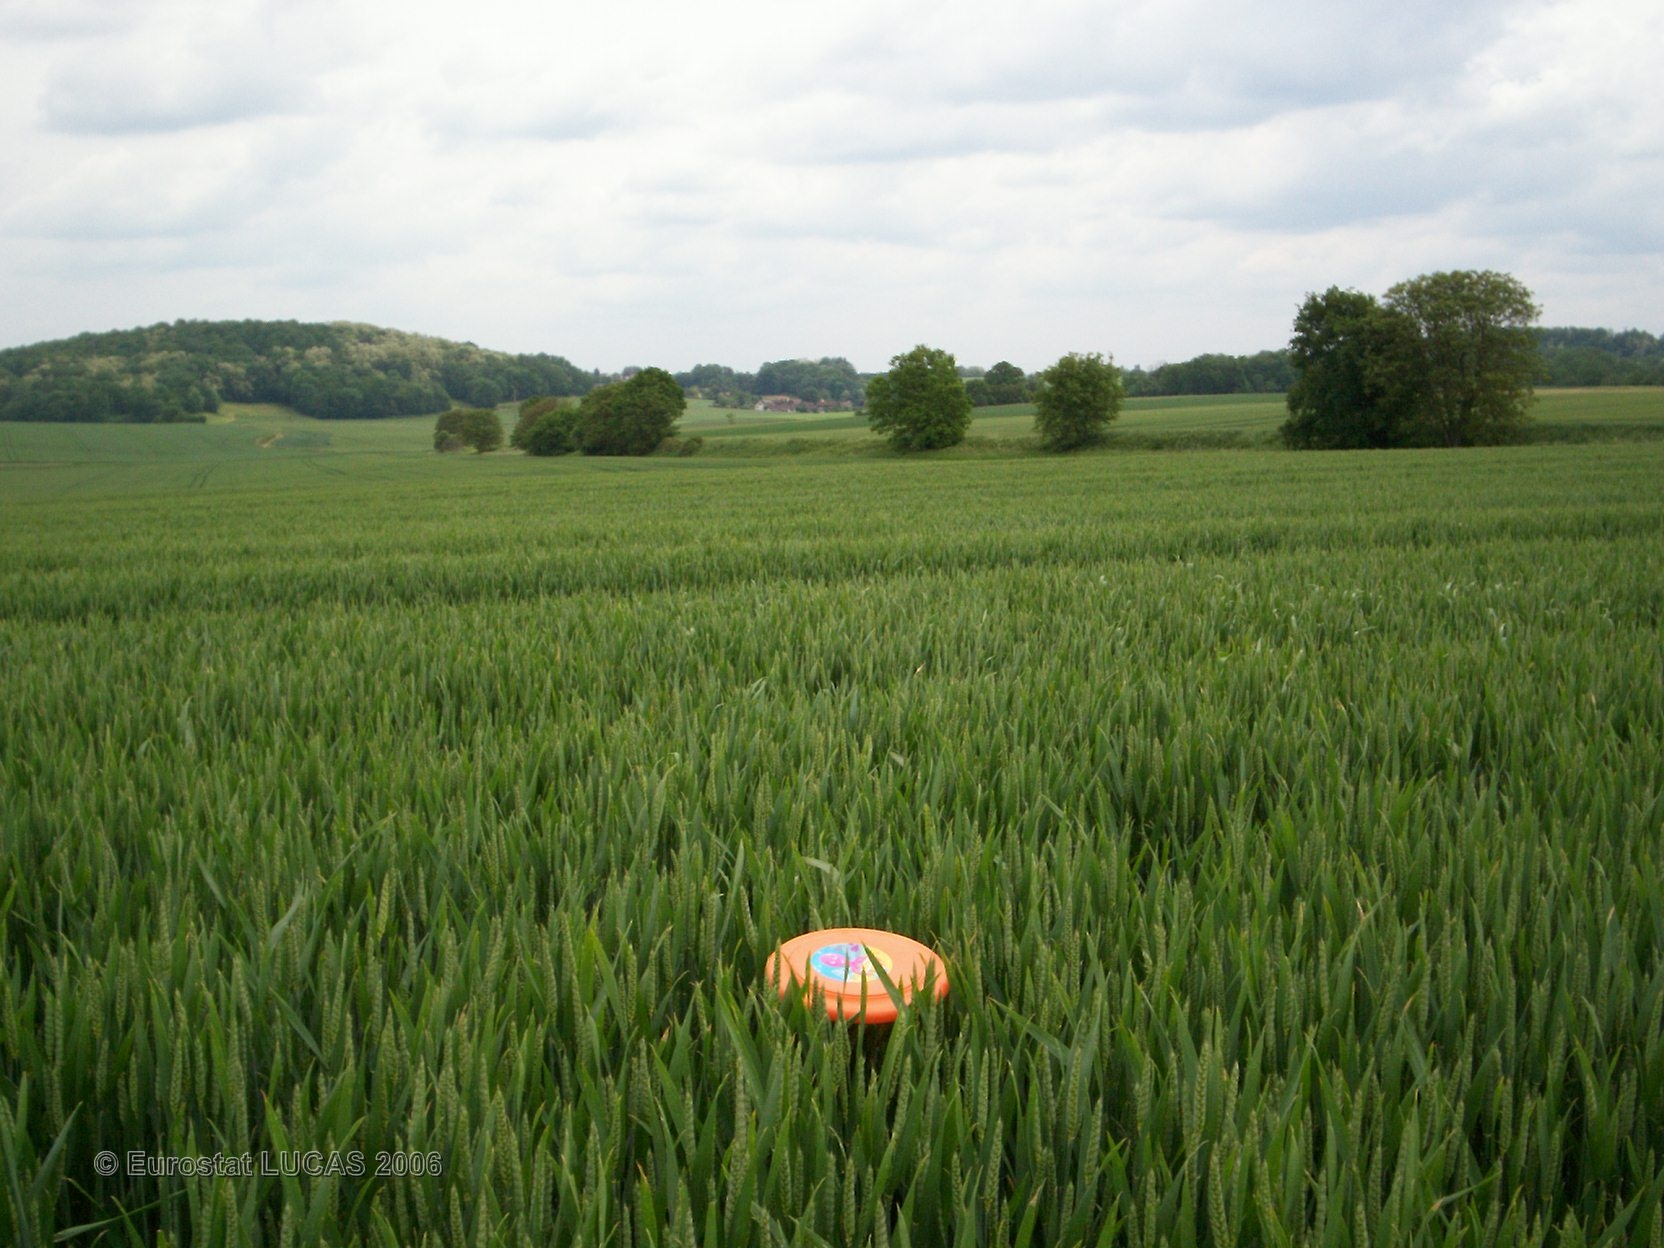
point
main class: Cropland
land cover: Common wheat
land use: Agriculture (excluding fallow land and kitchen gardens)
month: June
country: FR
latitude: 49.3743
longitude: 2.7312
